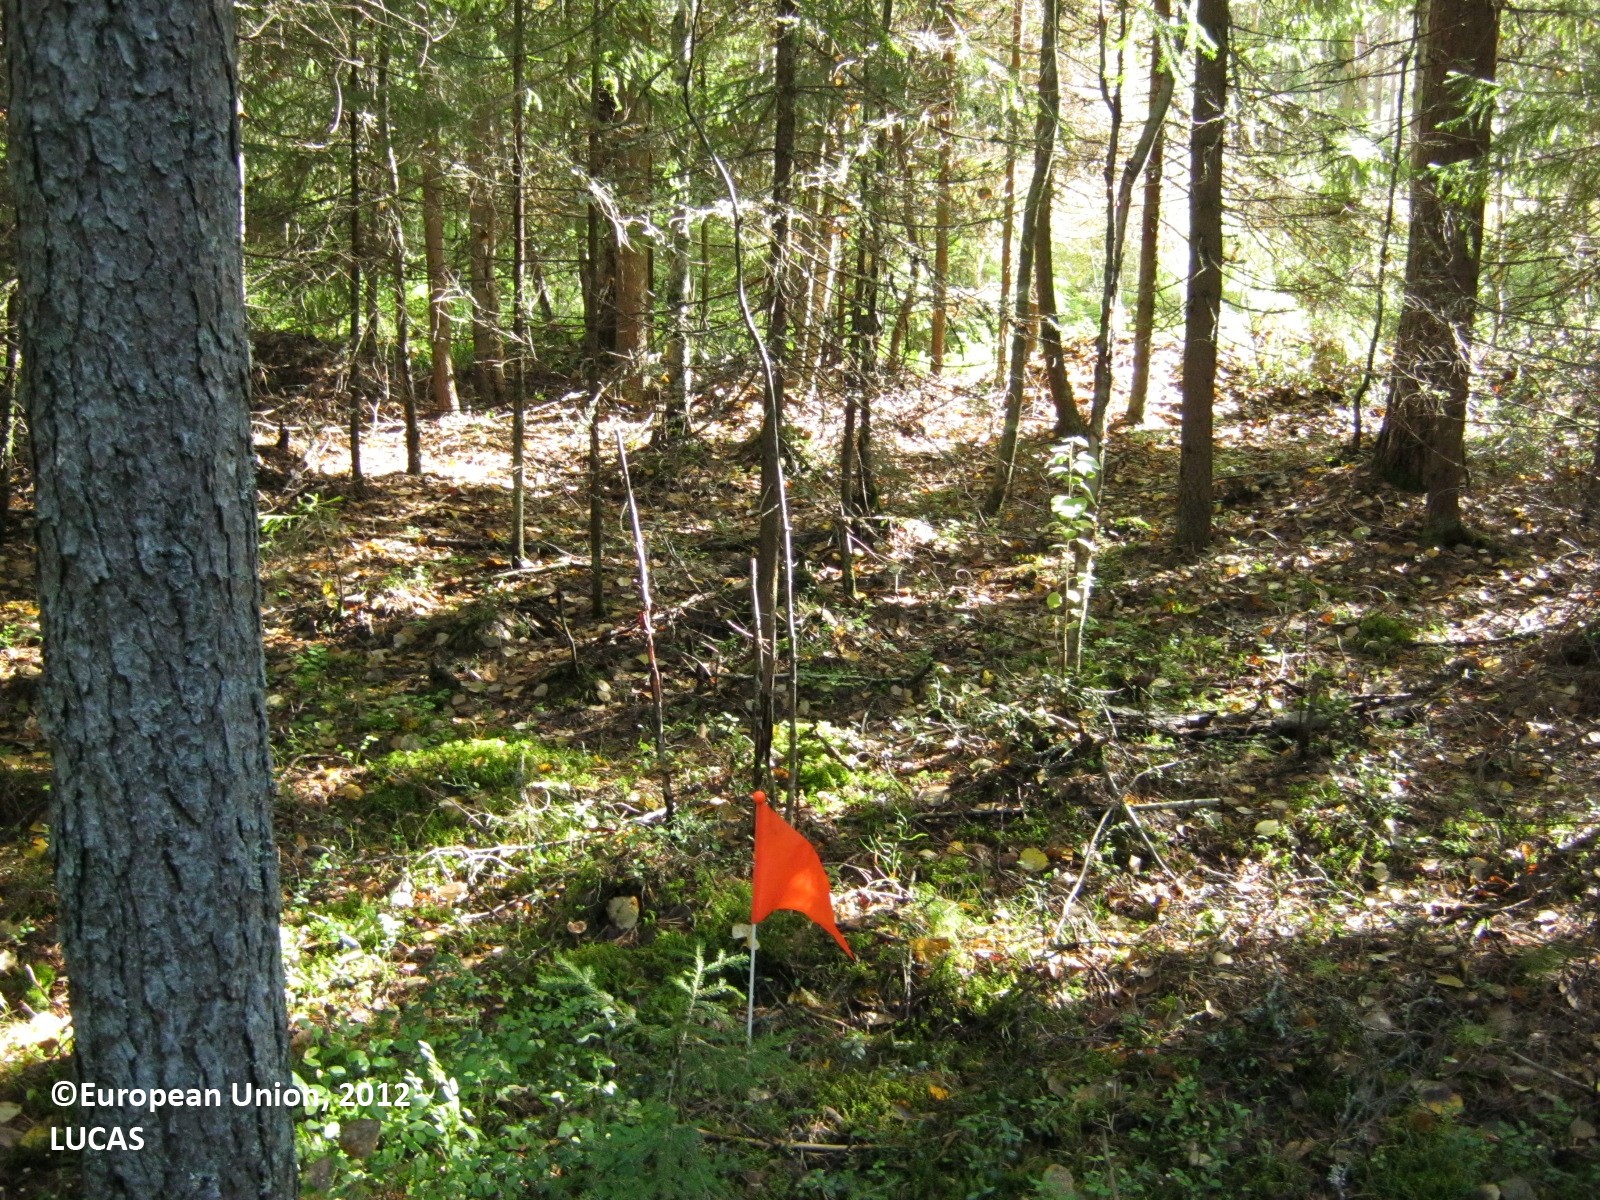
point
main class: Woodland
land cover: Other coniferous woodland
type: boreal forest
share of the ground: > 75 %
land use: Forestry
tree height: > 5 m
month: September
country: FI
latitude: 60.9309
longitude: 28.0430
